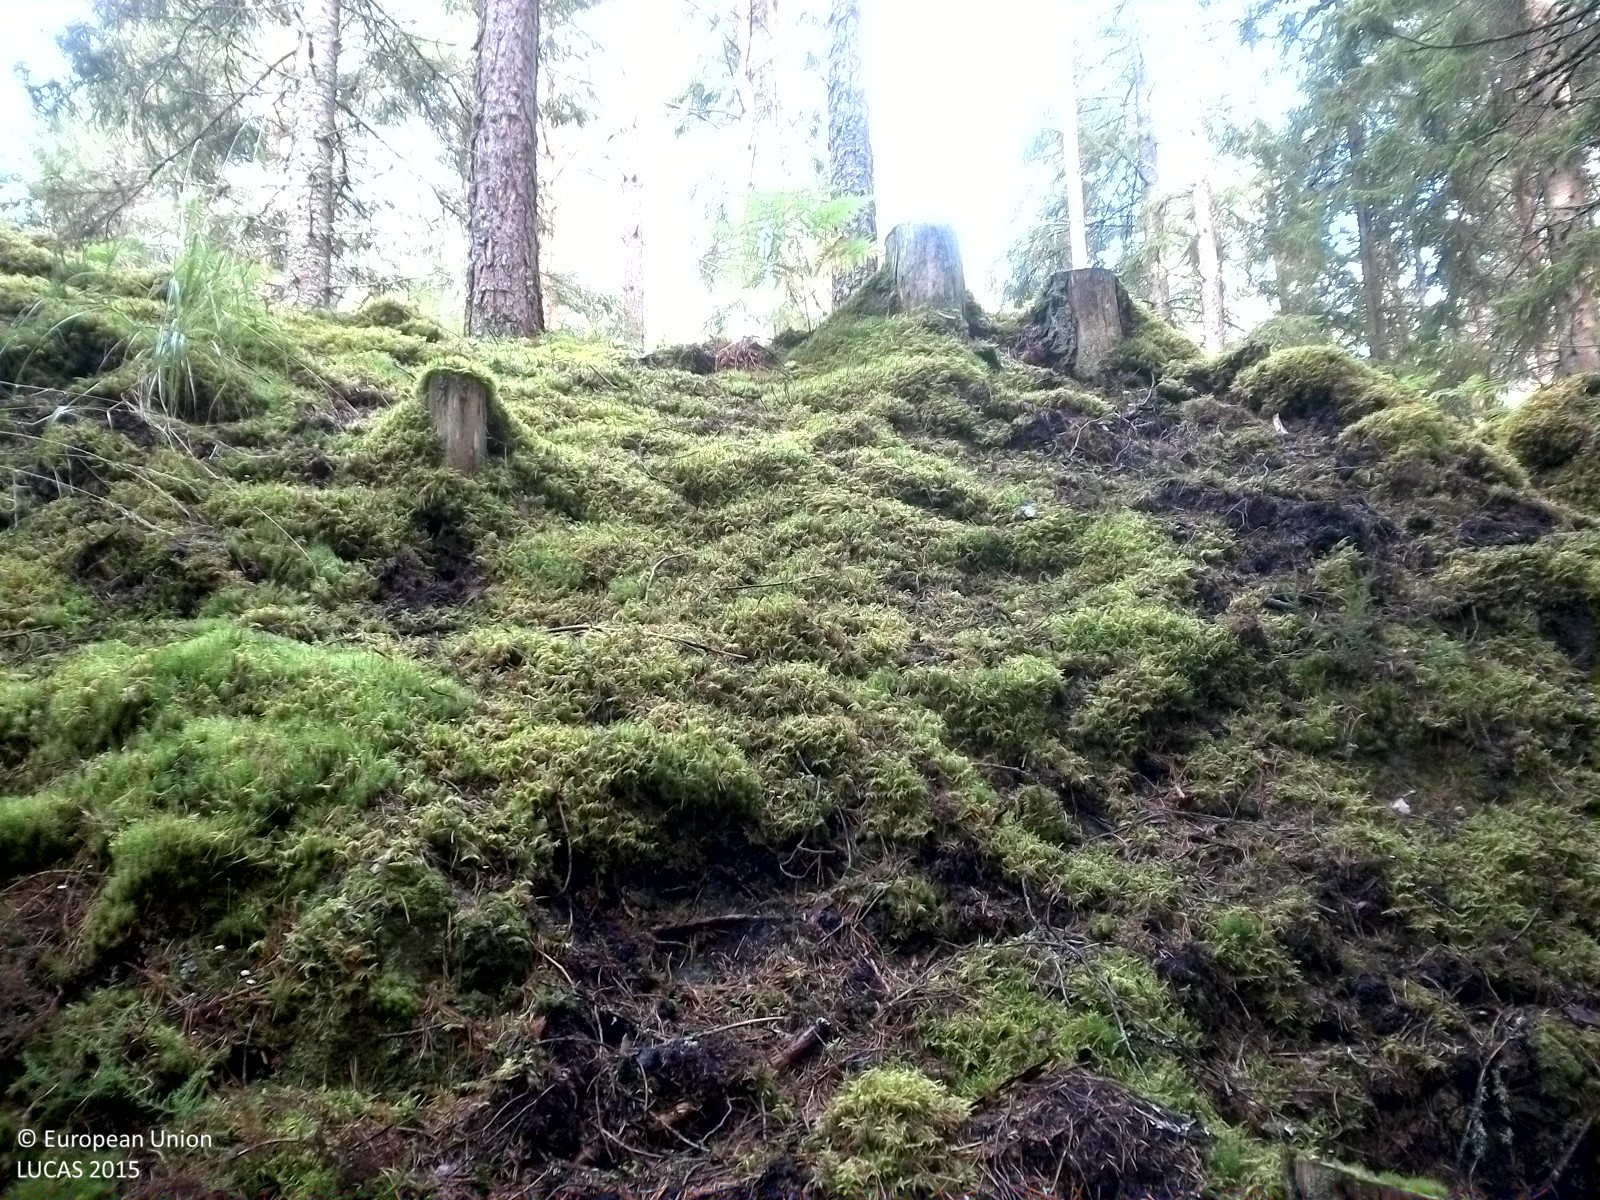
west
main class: Woodland
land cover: Spruce dominated coniferous woodland
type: boreal forest
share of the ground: 50 - 75 %
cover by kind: coniferous forest trees 55 %, lichens and mosses 30 %, unconsolidated bare surface 10 %, herbaceous plants 5 %
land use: Forestry
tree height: > 5 m
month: August
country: SE
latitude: 58.9546
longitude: 15.5037
